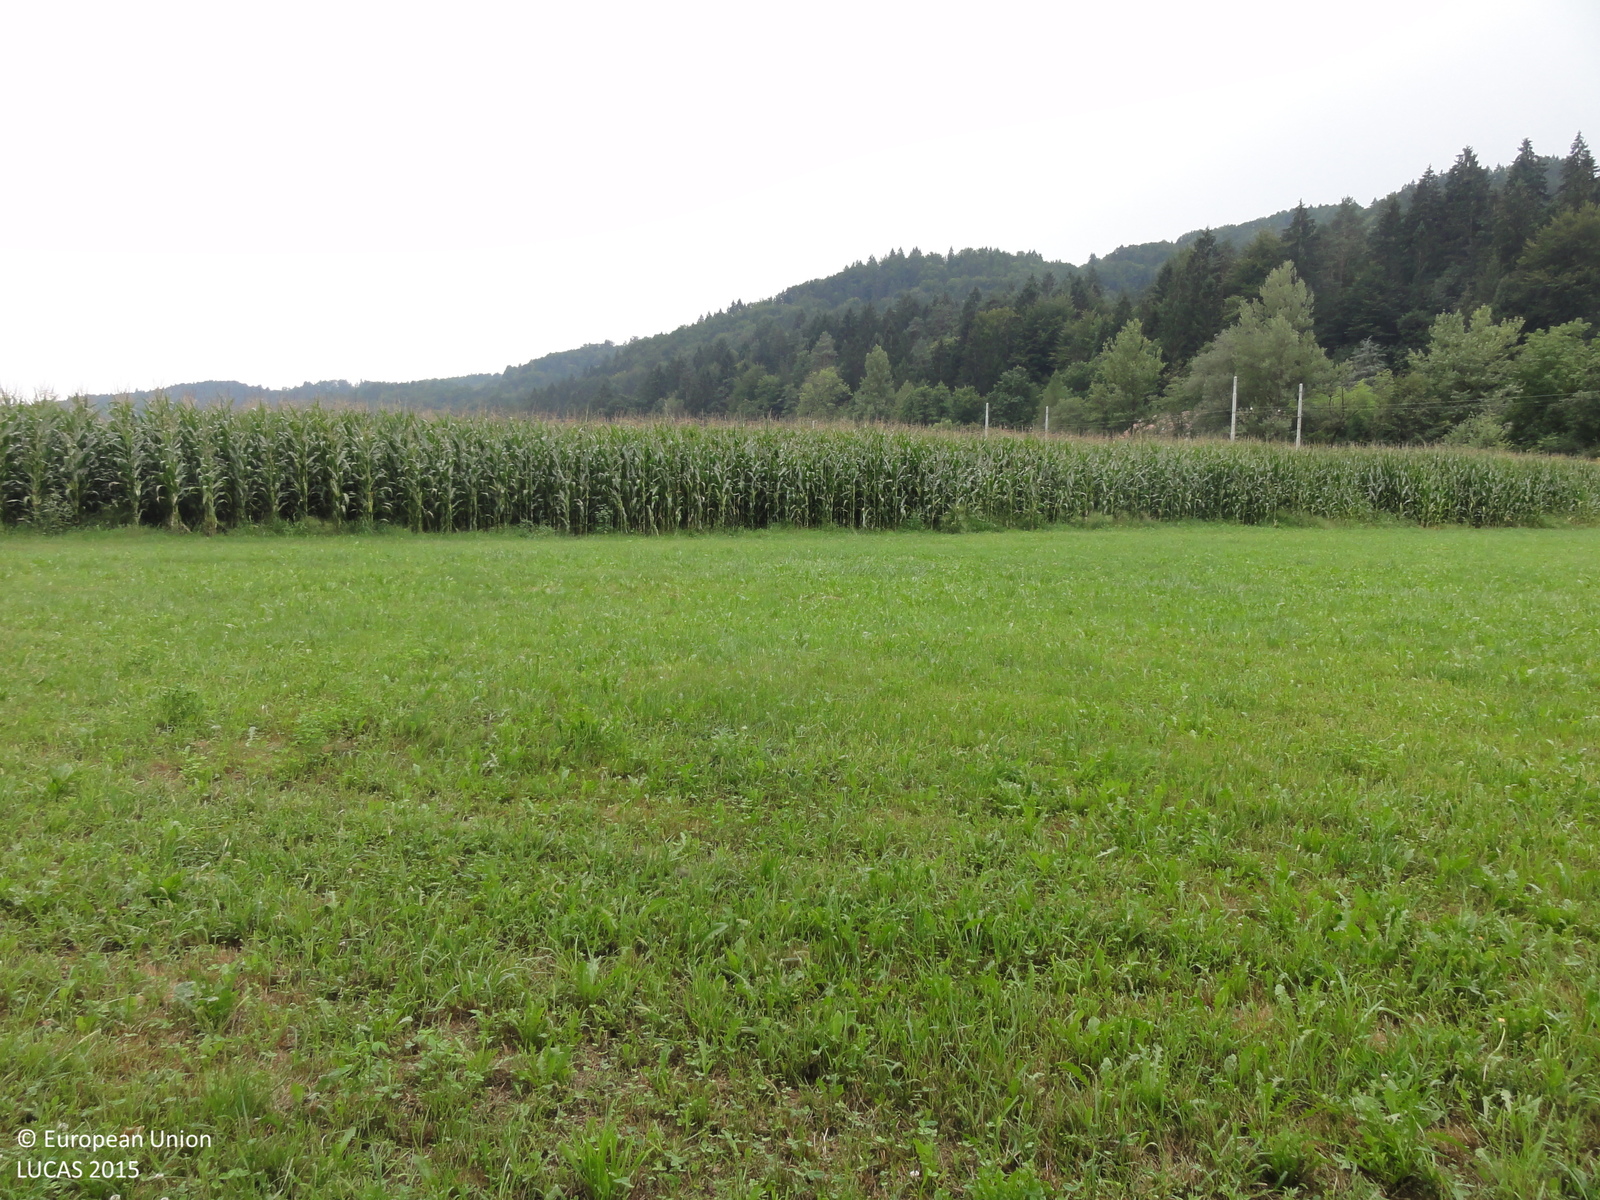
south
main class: Grassland
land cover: Grassland without tree/shrub cover
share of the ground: > 75 %
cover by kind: herbaceous plants 100 %
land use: Agriculture (excluding fallow land and kitchen gardens)
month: August
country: SI
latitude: 46.0993
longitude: 14.7959
